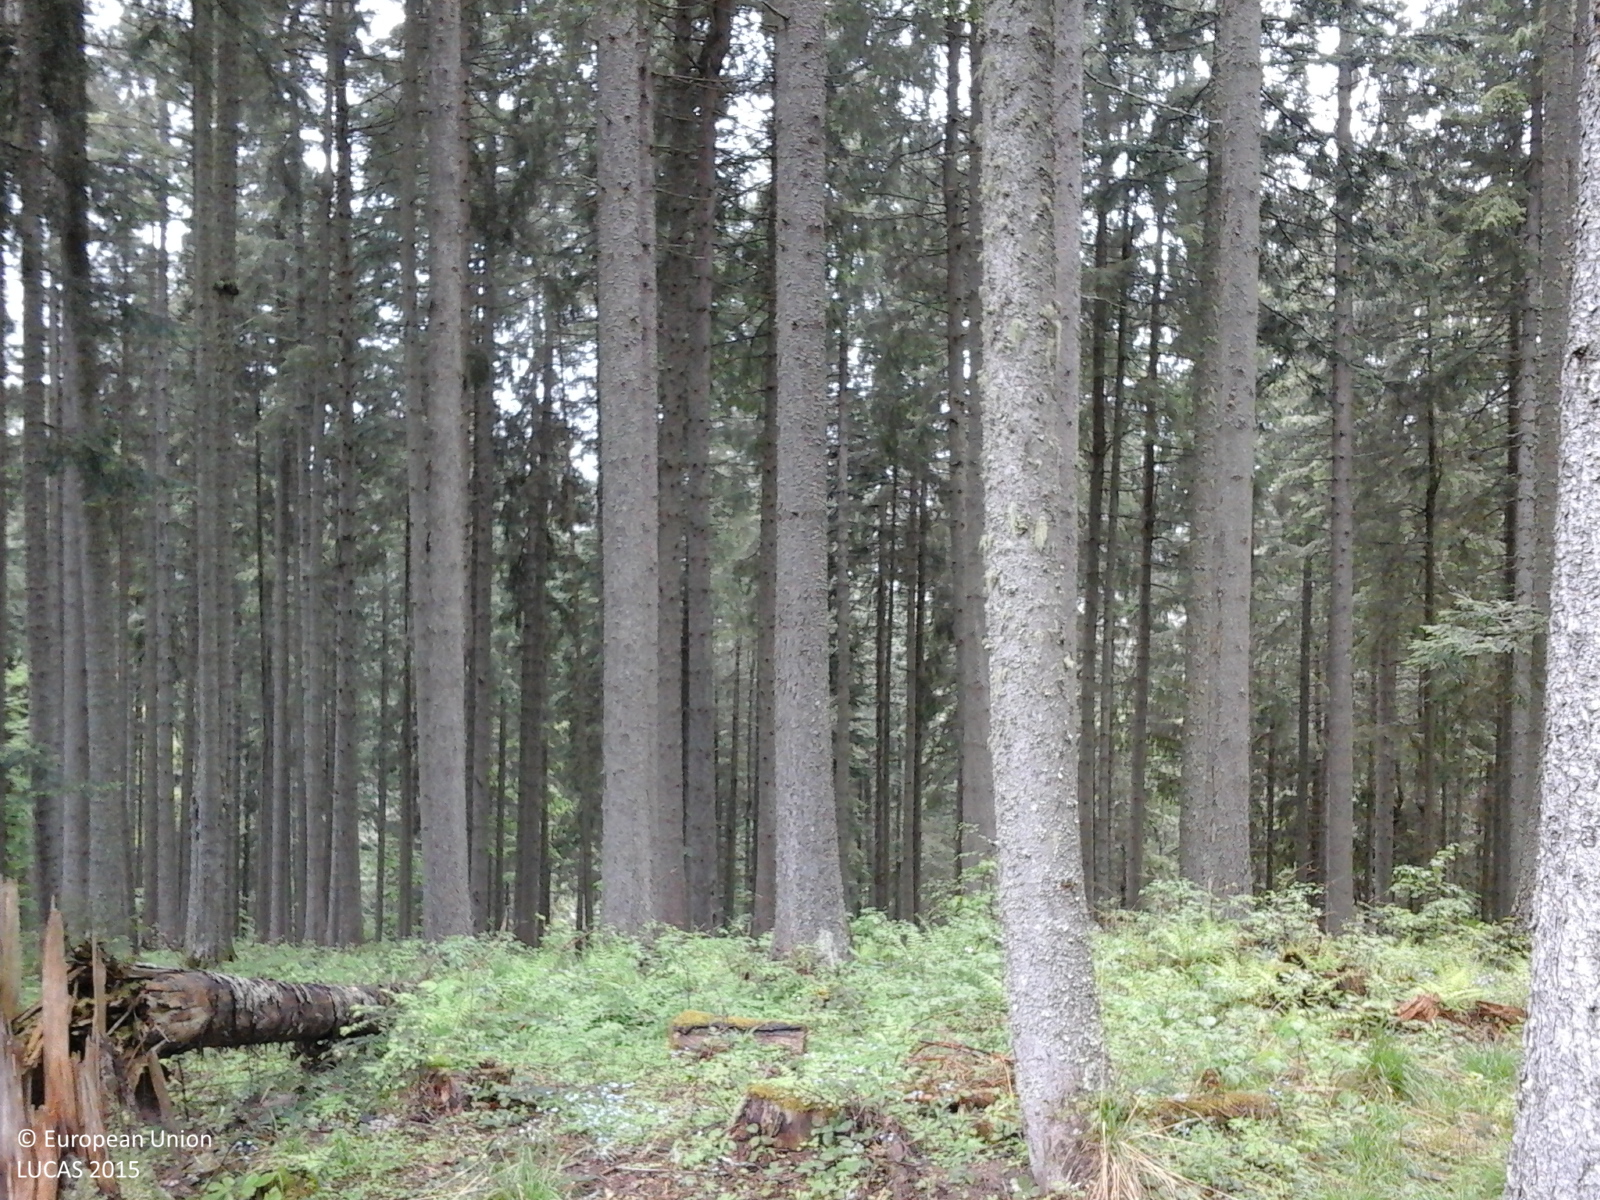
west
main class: Woodland
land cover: Spruce dominated coniferous woodland
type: alpine coniferous forest
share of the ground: > 75 %
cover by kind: coniferous forest trees 90 %, broadleaved forest trees 10 %
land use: Forestry
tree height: > 5 m
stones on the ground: < 10 %
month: May
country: RO
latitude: 45.4875
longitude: 25.6238
